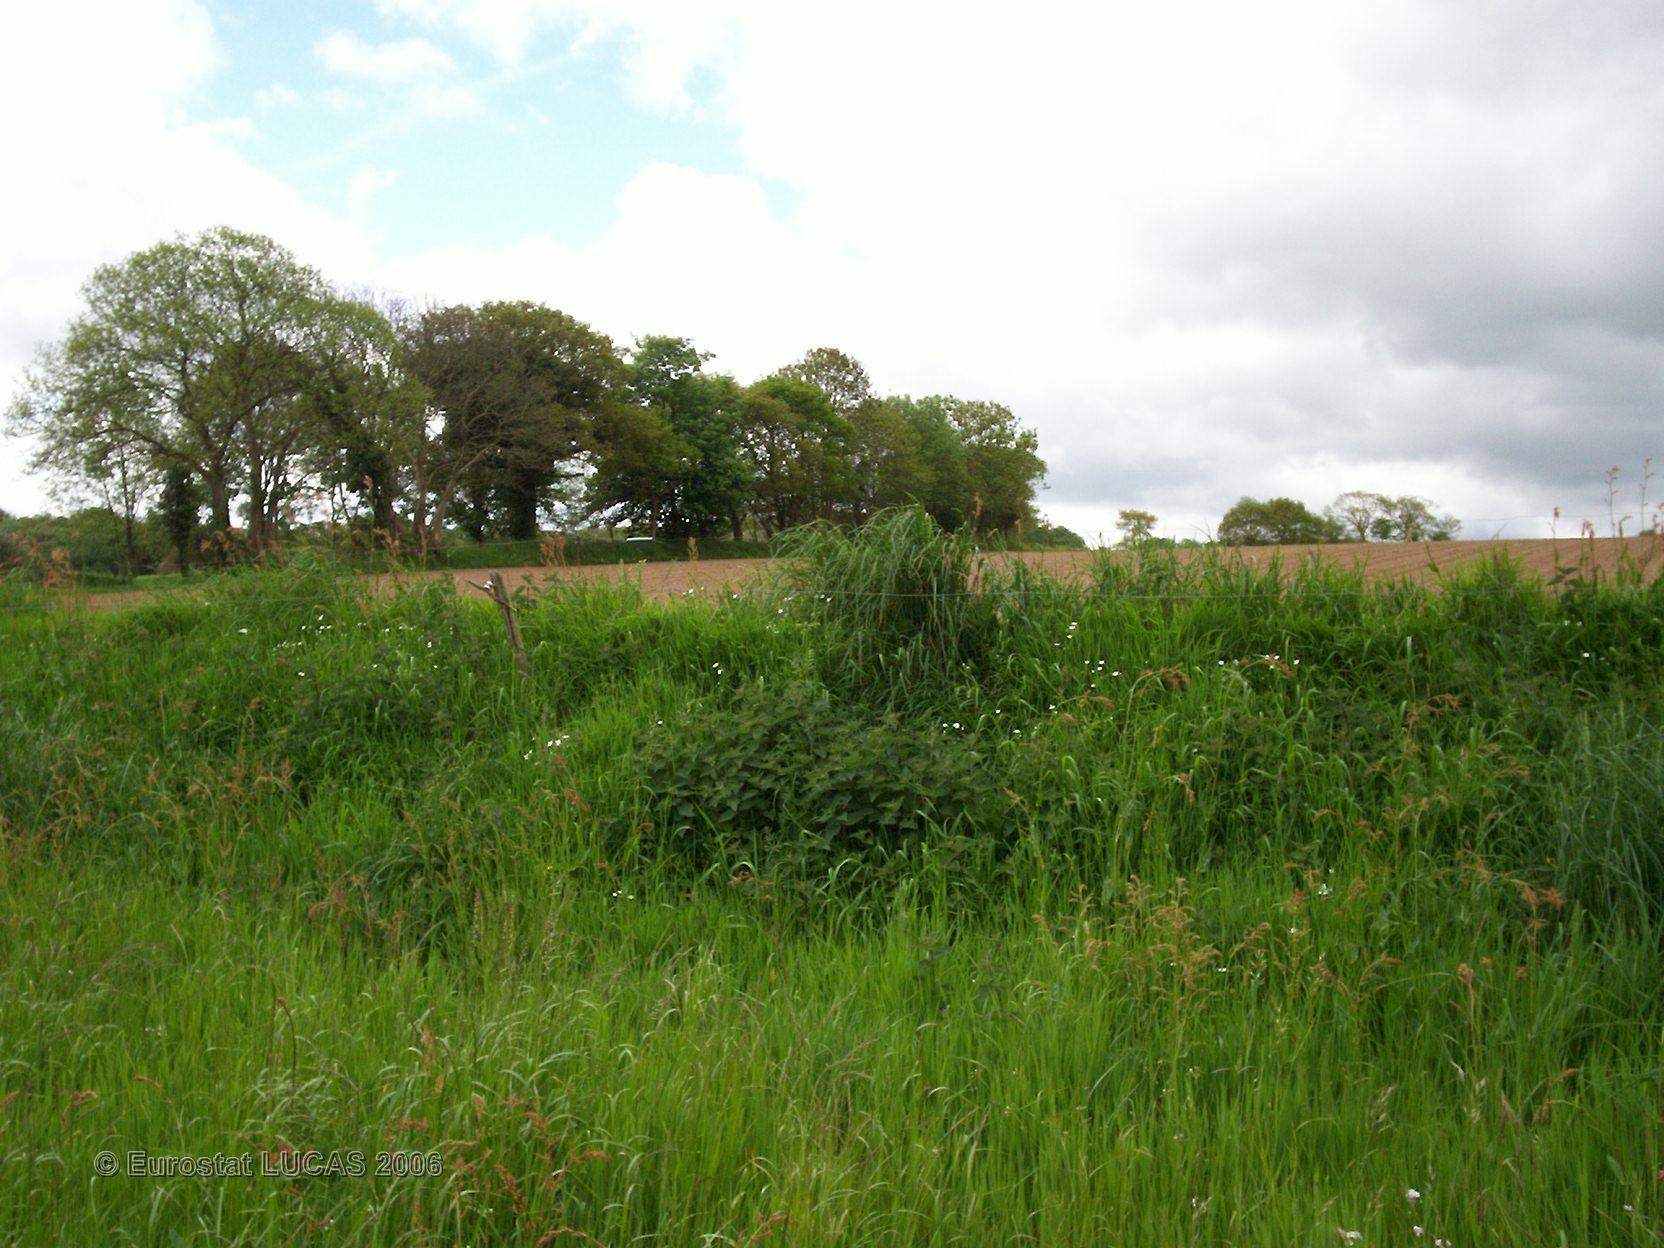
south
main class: Grassland
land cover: Grassland without tree/shrub cover
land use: Agriculture (excluding fallow land and kitchen gardens)
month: May
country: FR
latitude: 48.5816
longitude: -3.7341
